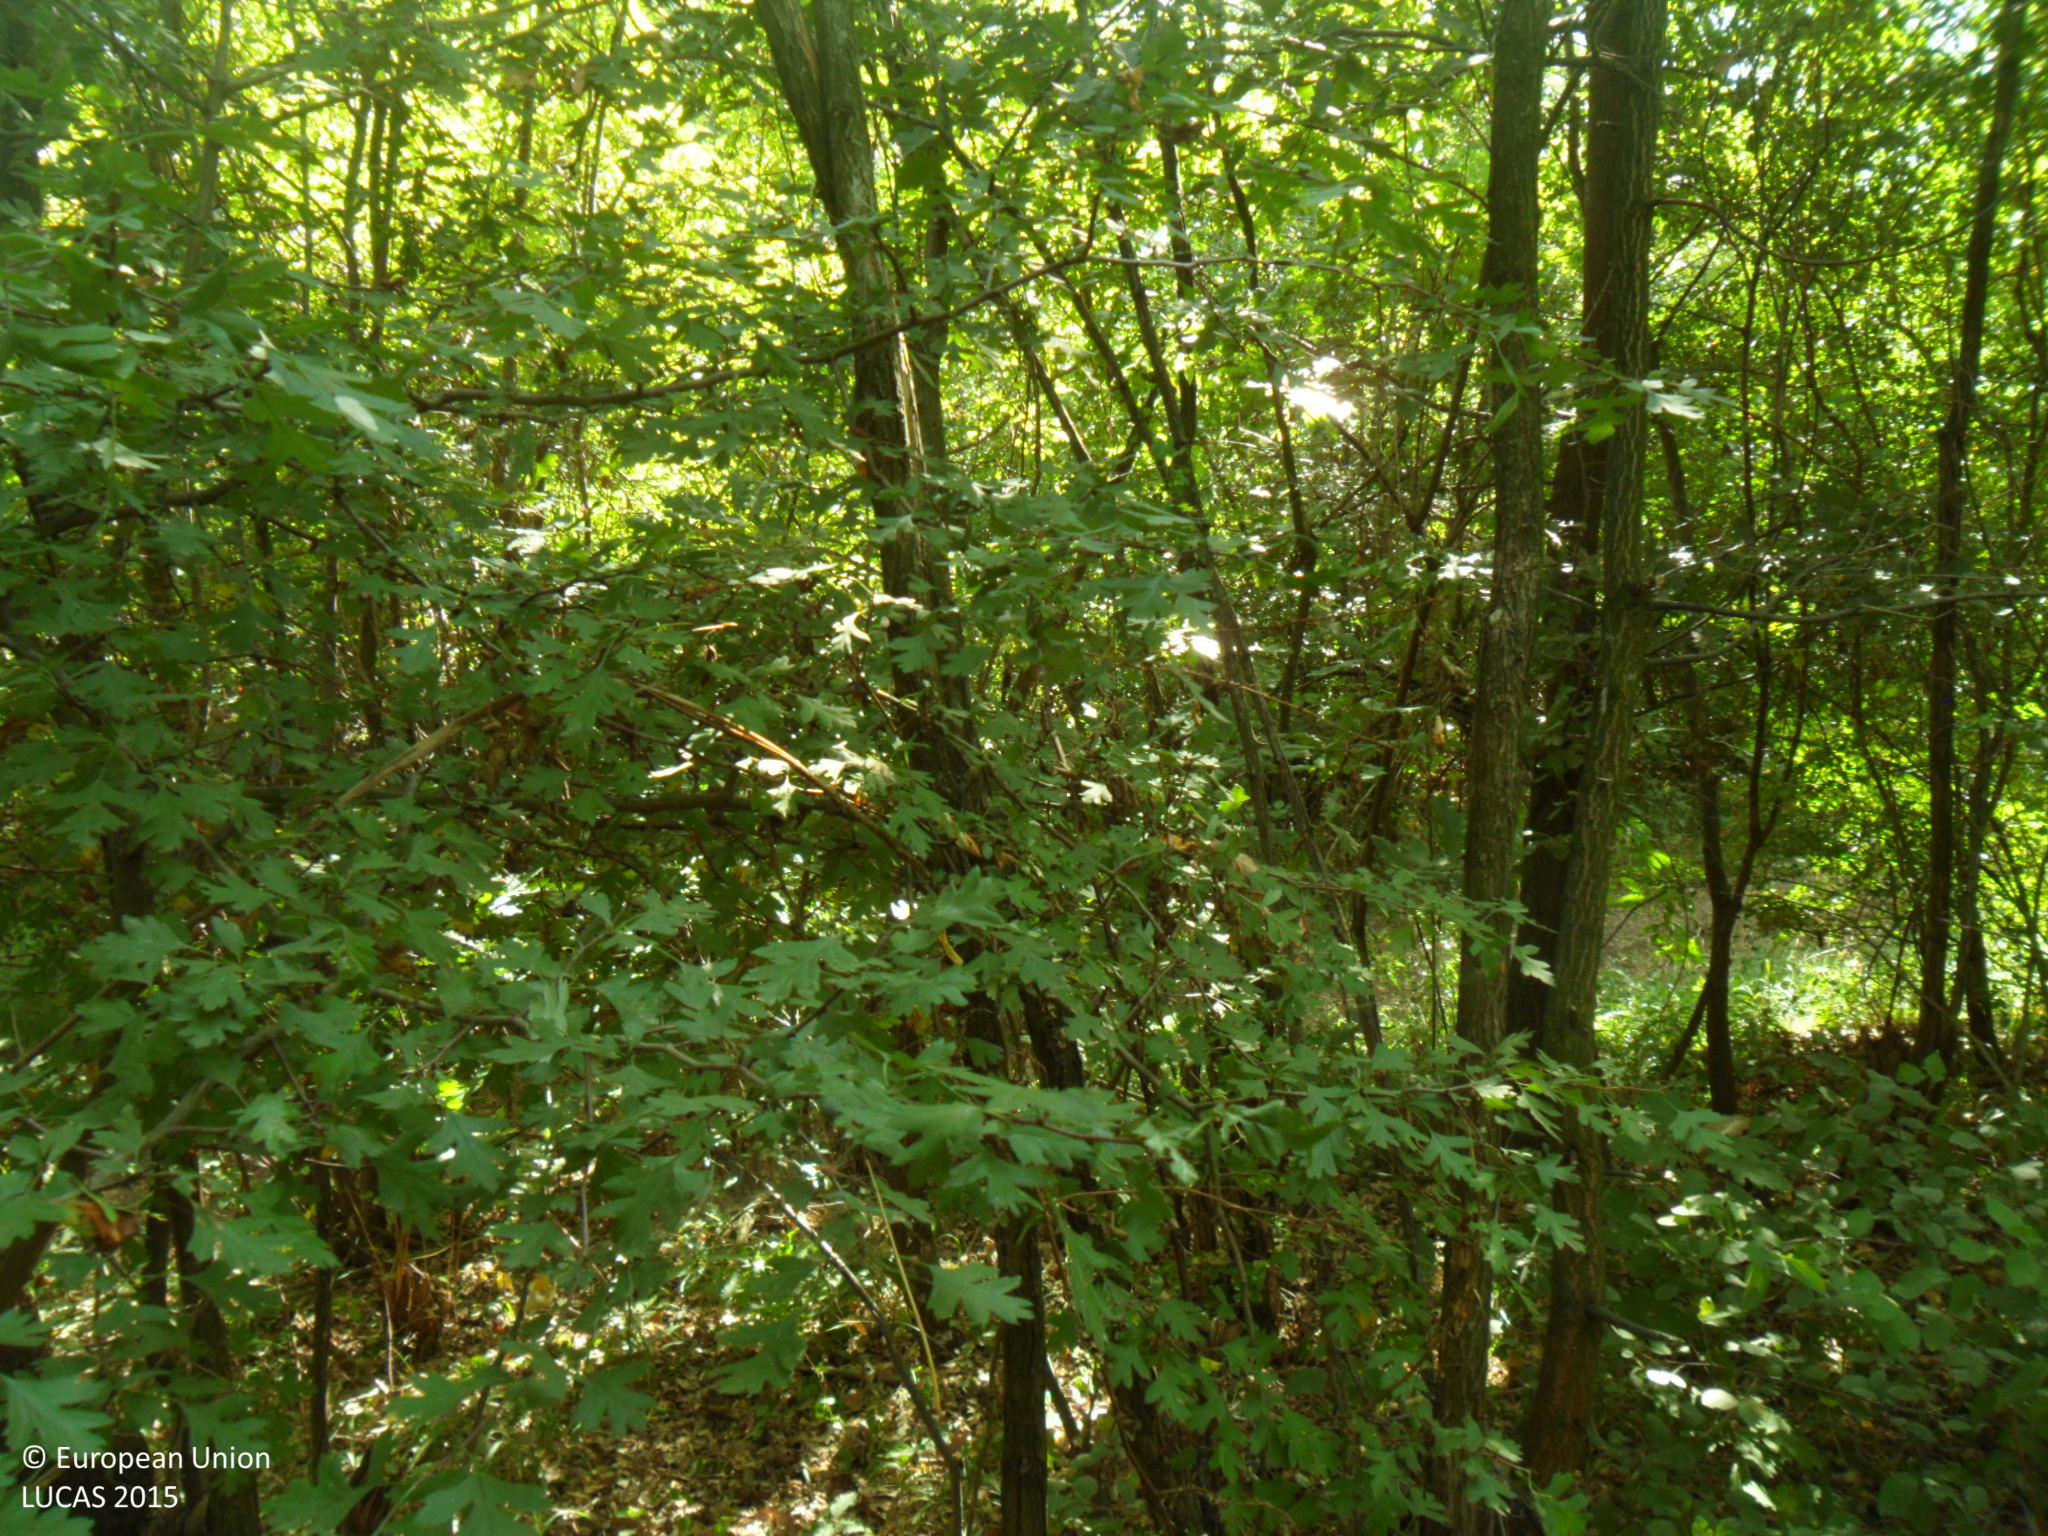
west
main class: Woodland
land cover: Broadleaved woodland
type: mesophytic deciduous forest
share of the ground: > 75 %
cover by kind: broadleaved forest trees 95 %, unconsolidated bare surface 5 %
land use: Forestry
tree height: > 5 m
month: August
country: BG
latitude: 43.5189
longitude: 26.6998
